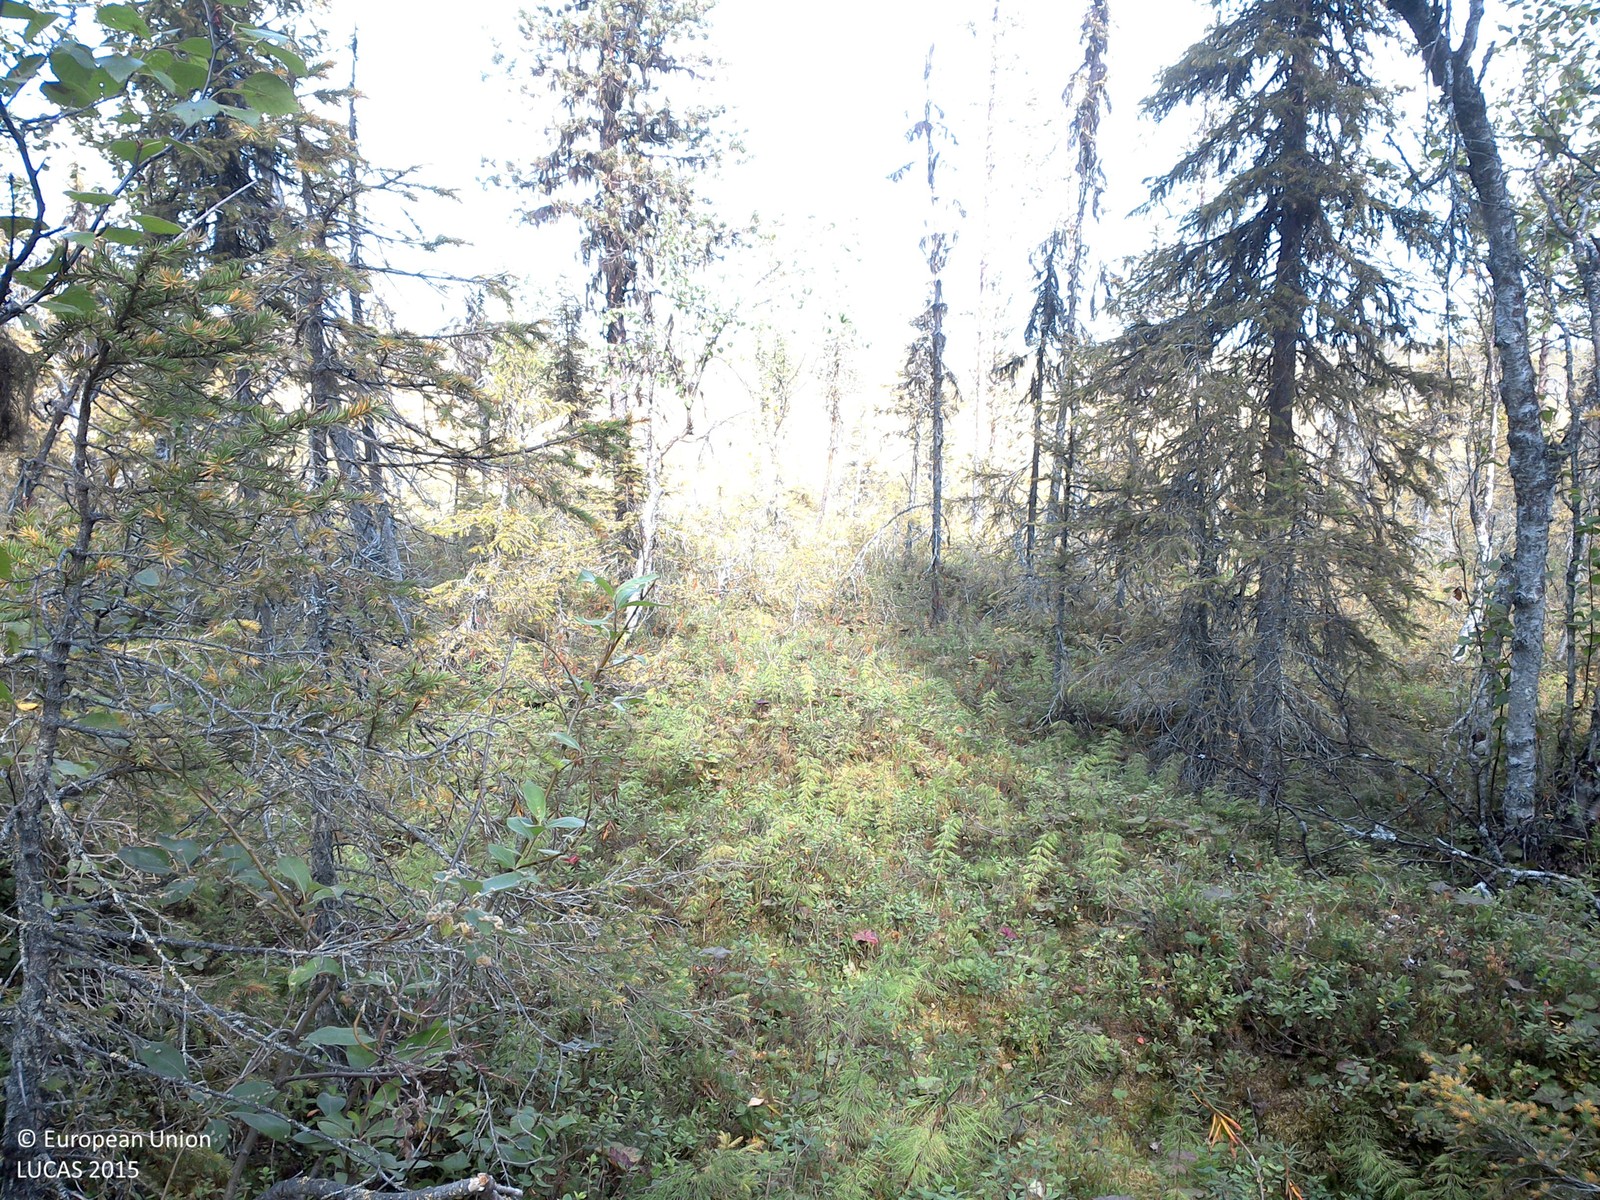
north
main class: Woodland
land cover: Spruce dominated coniferous woodland
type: boreal forest
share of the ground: 25 - 50 %
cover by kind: shrubs 40 %, coniferous forest trees 20 %, herbaceous plants 20 %, lichens and mosses 15 %, broadleaved forest trees 5 %
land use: Forestry
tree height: > 5 m
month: August
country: SE
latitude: 67.3180
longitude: 21.9699
